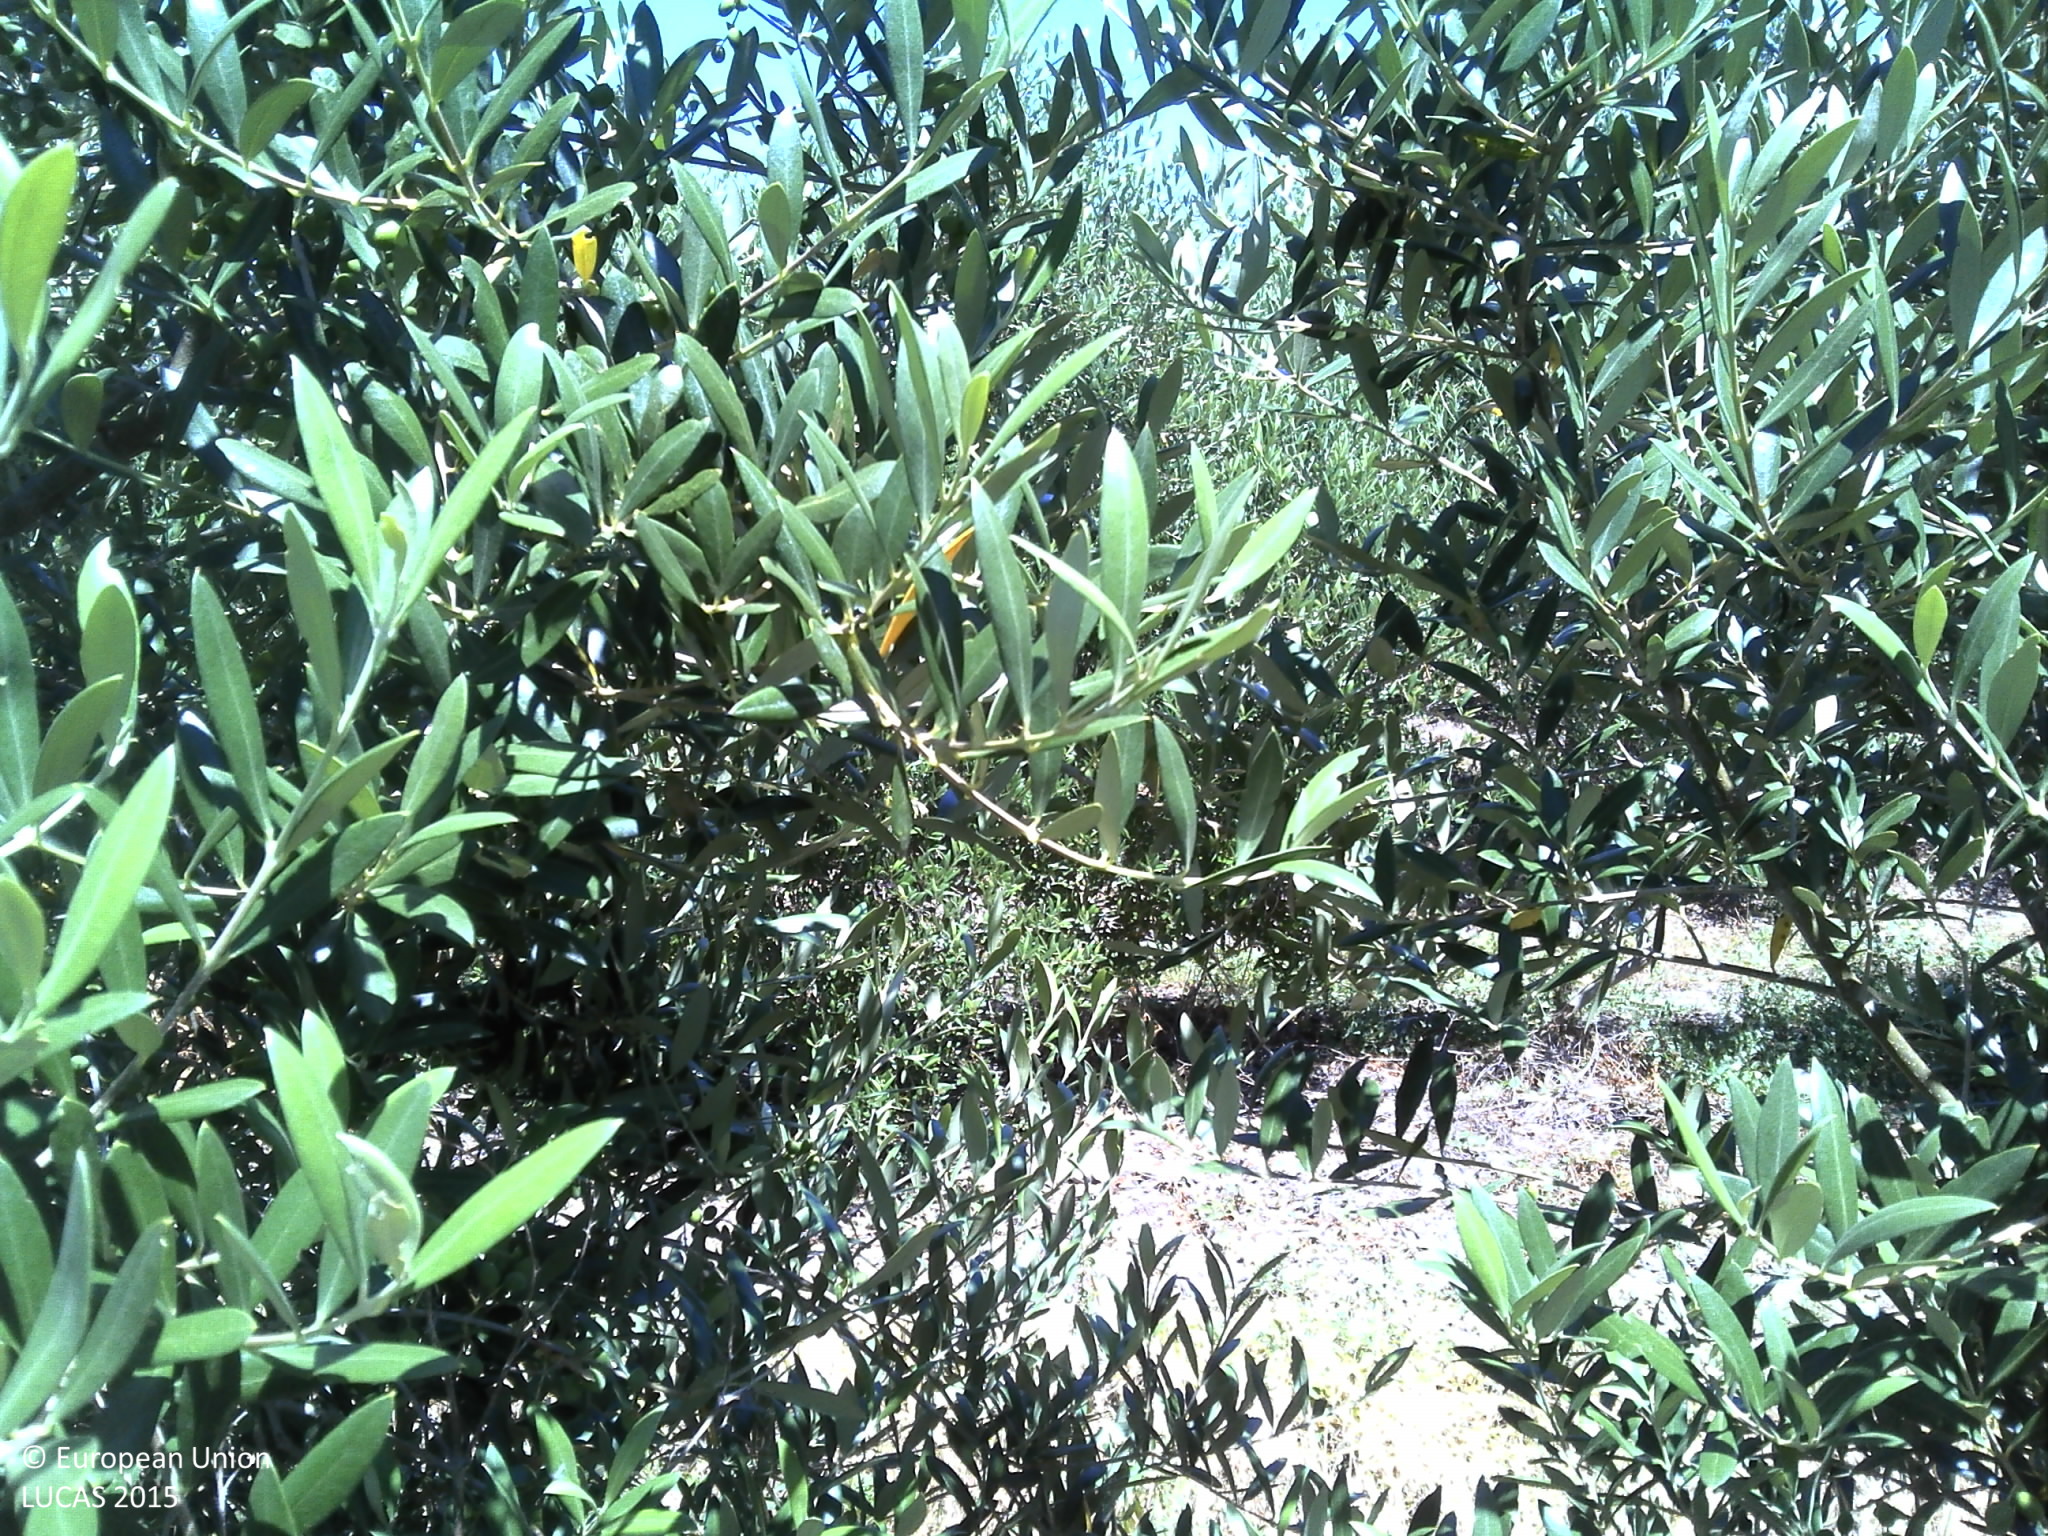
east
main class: Cropland
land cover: Olive groves
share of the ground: 50 - 75 %
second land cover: Grassland without tree/shrub cover
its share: 25 - 50 %
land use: Agriculture (excluding fallow land and kitchen gardens)
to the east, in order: Olive groves; Grassland without tree/shrub cover; Olive groves
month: June
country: PT
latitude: 37.9538
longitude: -7.5341
